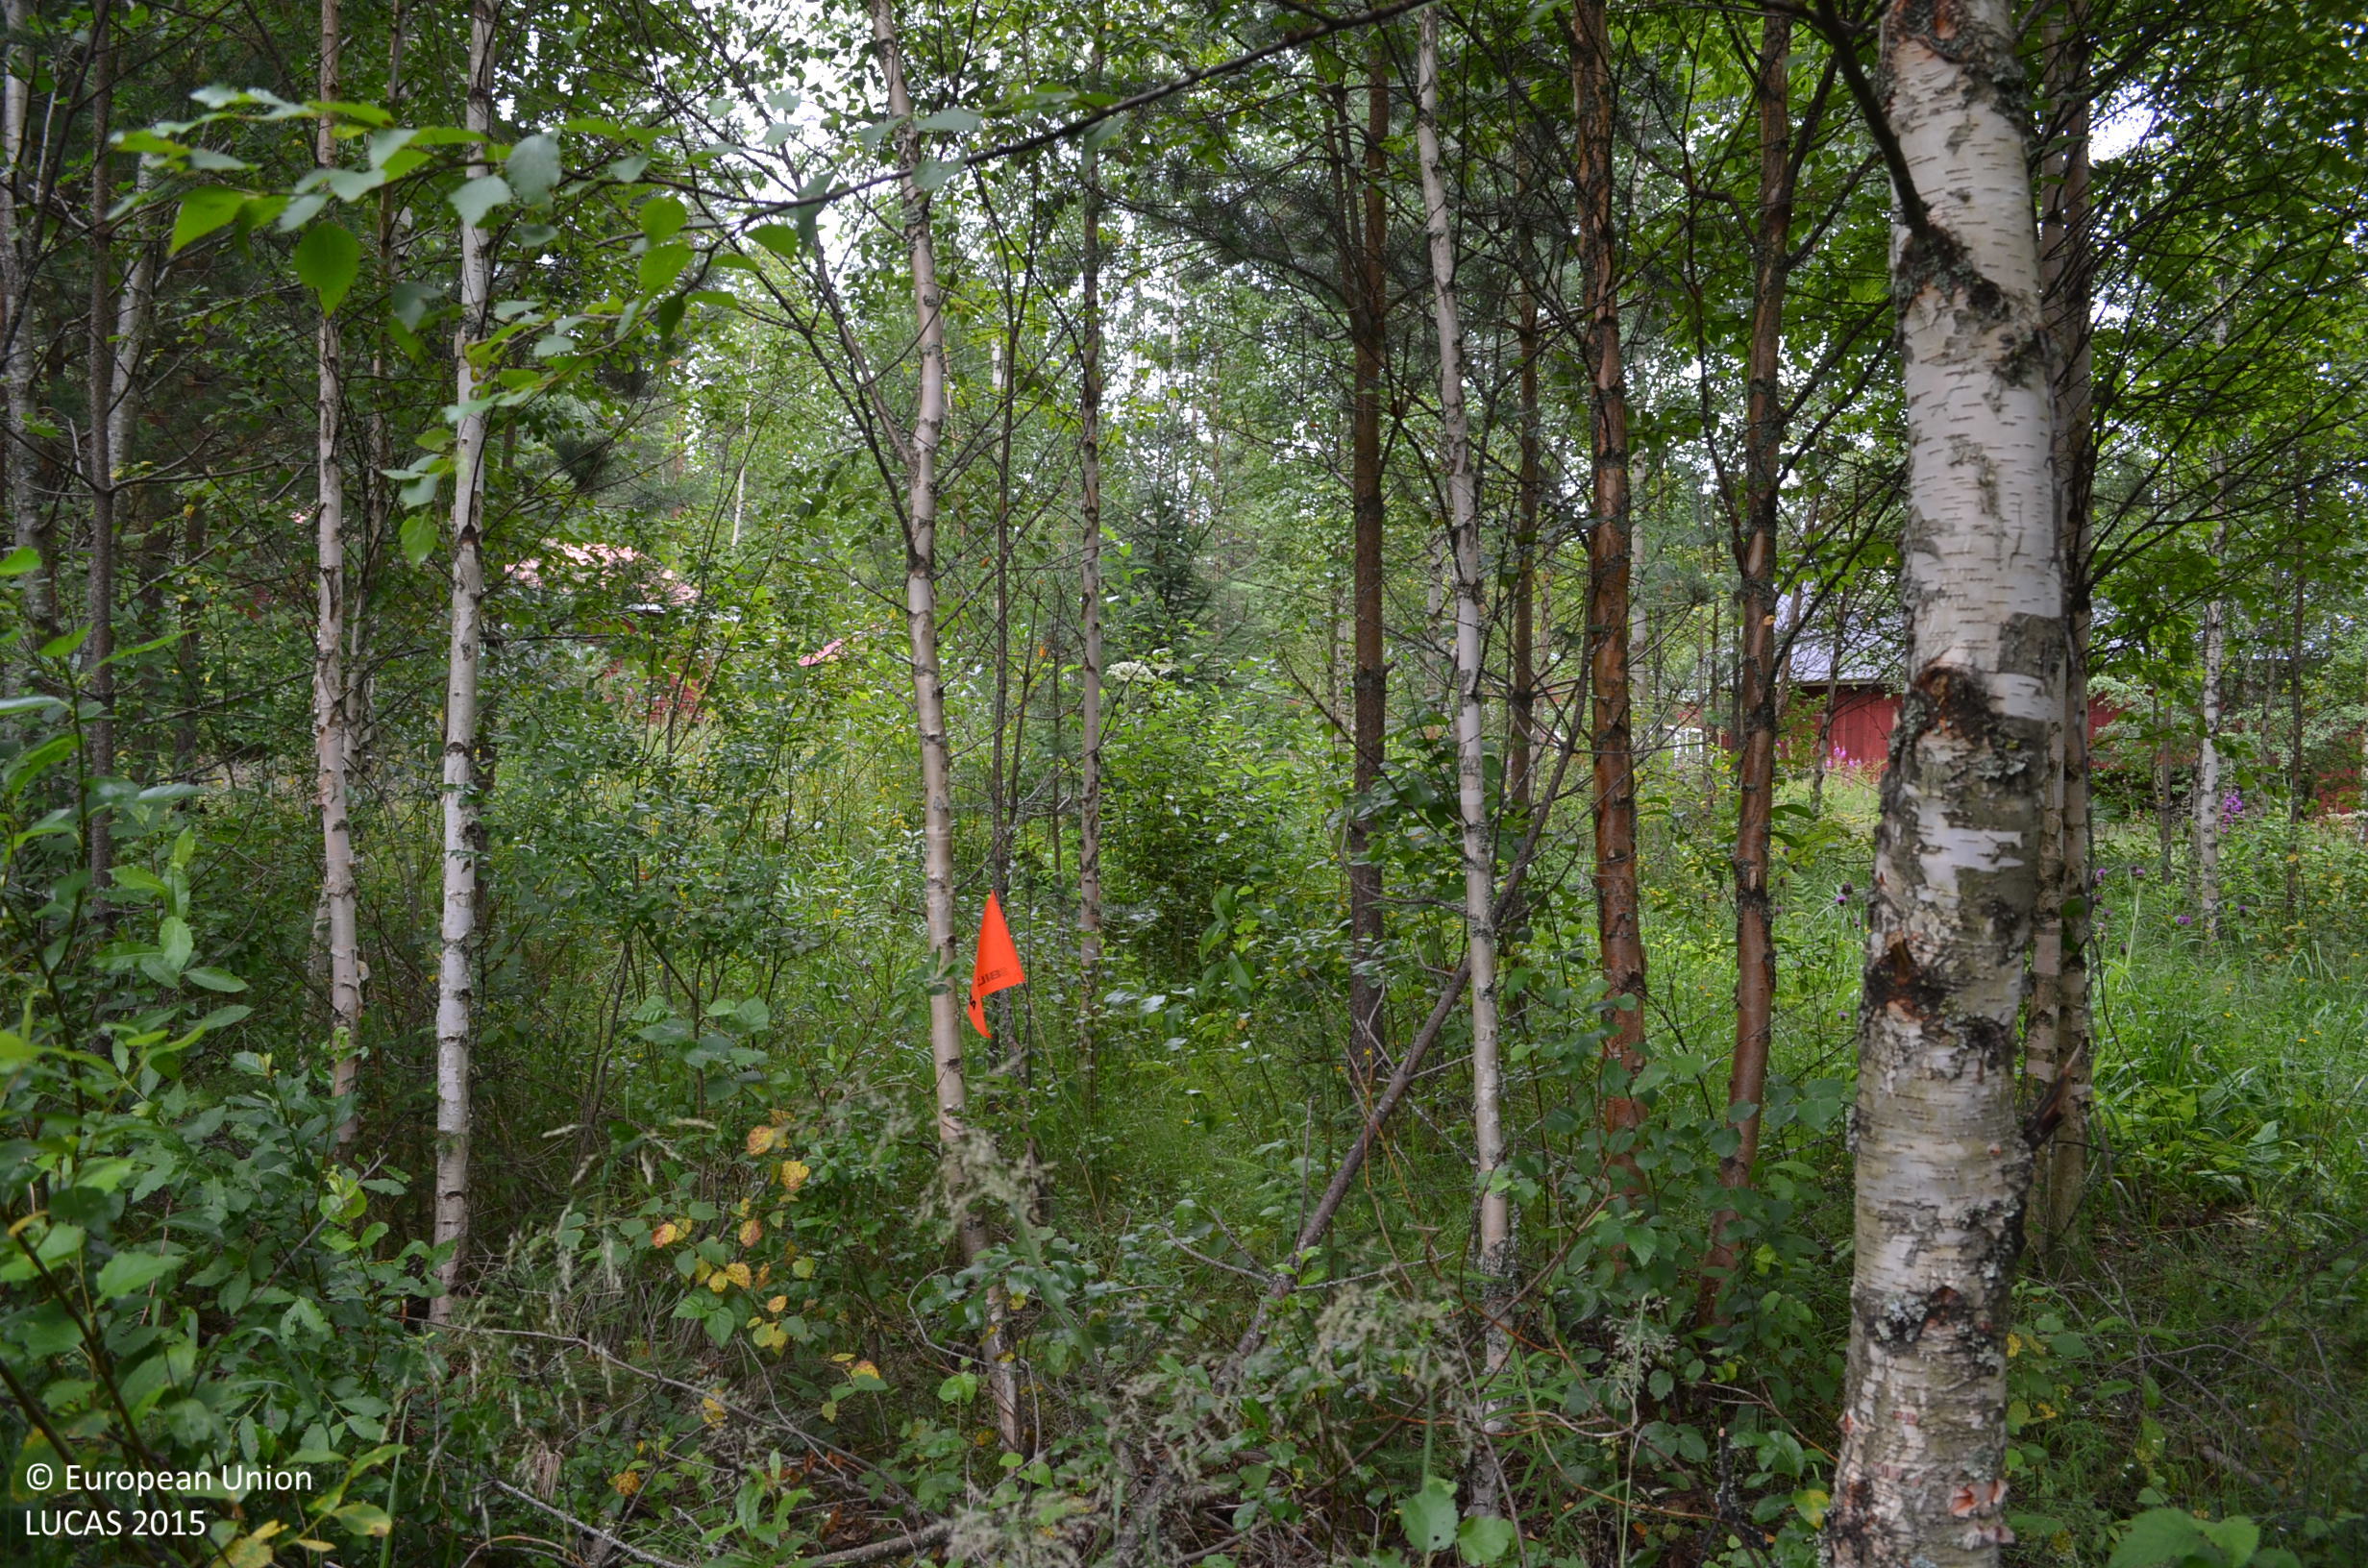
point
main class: Woodland
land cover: Pine dominated mixed woodland
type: boreal forest
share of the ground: 50 - 75 %
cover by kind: coniferous forest trees 30 %, broadleaved forest trees 30 %, herbaceous plants 30 %, shrubs 10 %
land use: Forestry
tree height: > 5 m
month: August
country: FI
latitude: 61.8776
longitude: 24.2197
